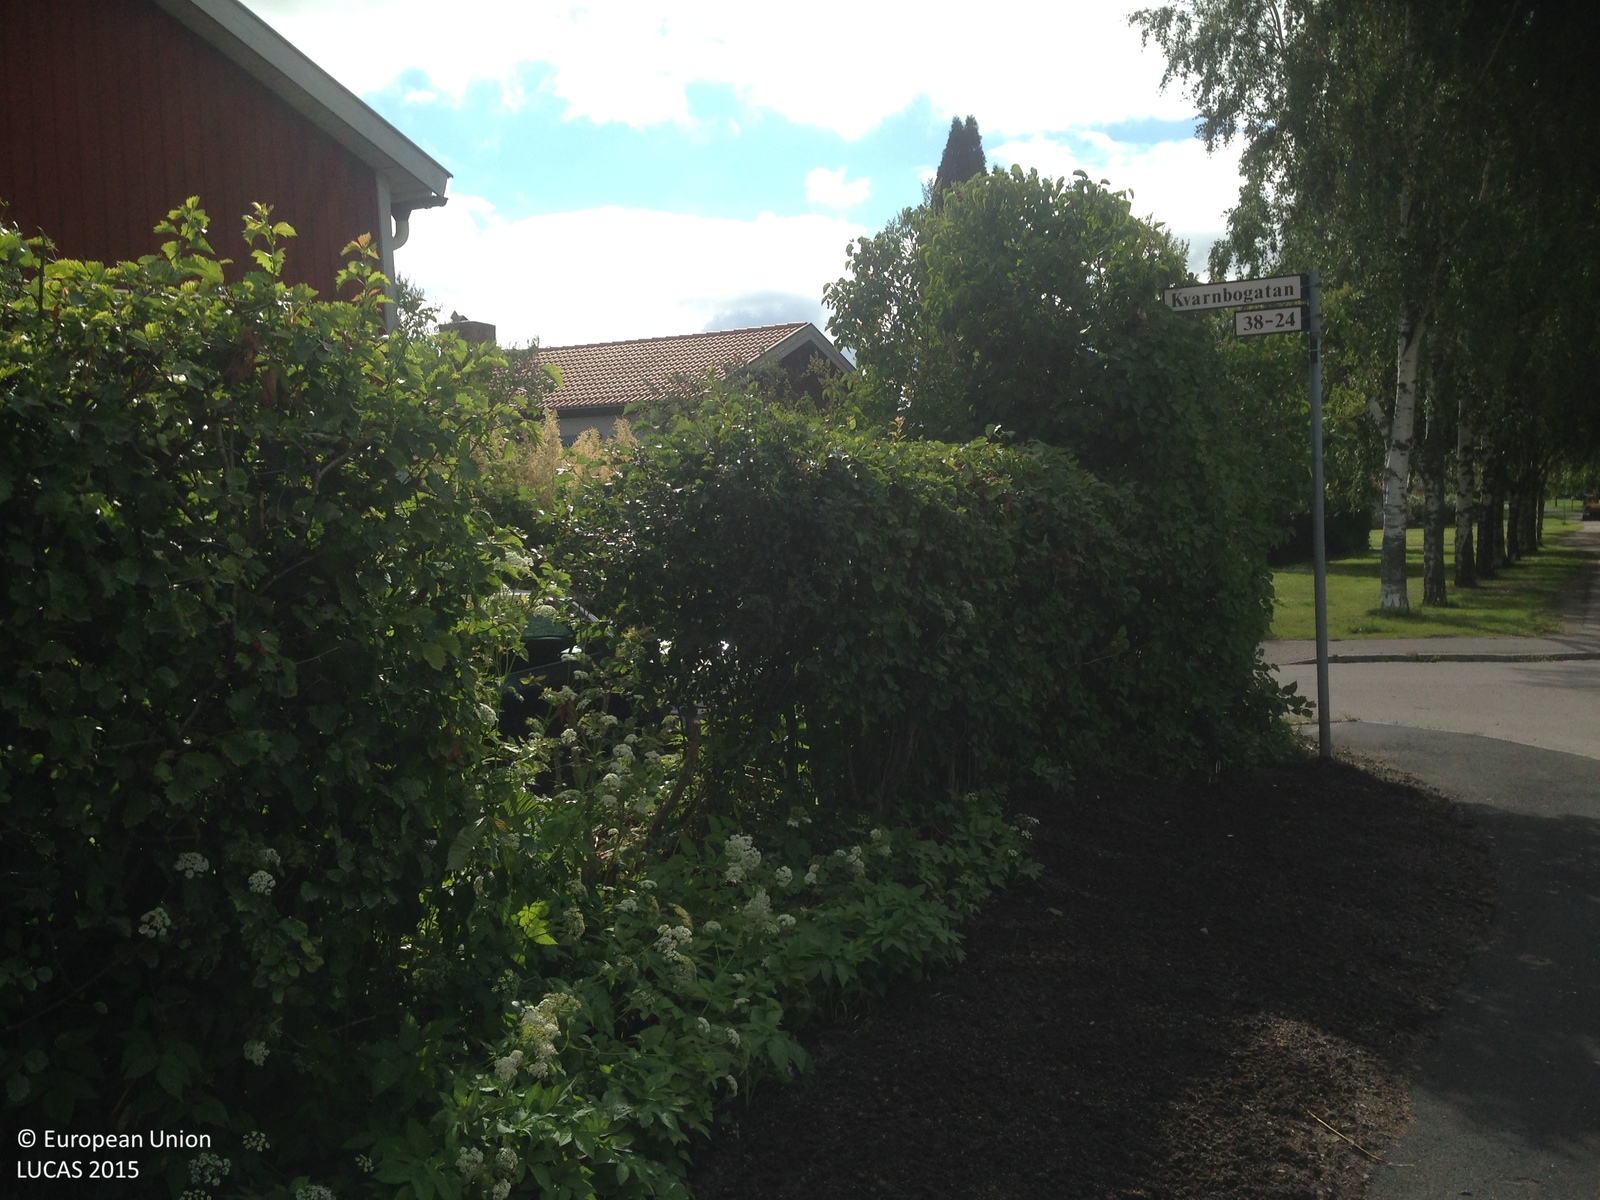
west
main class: Cropland
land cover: Apple fruit
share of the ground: > 75 %
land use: Kitchen garden
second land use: Amenities, museums, leisure
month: July
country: SE
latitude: 59.8481
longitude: 17.6156
